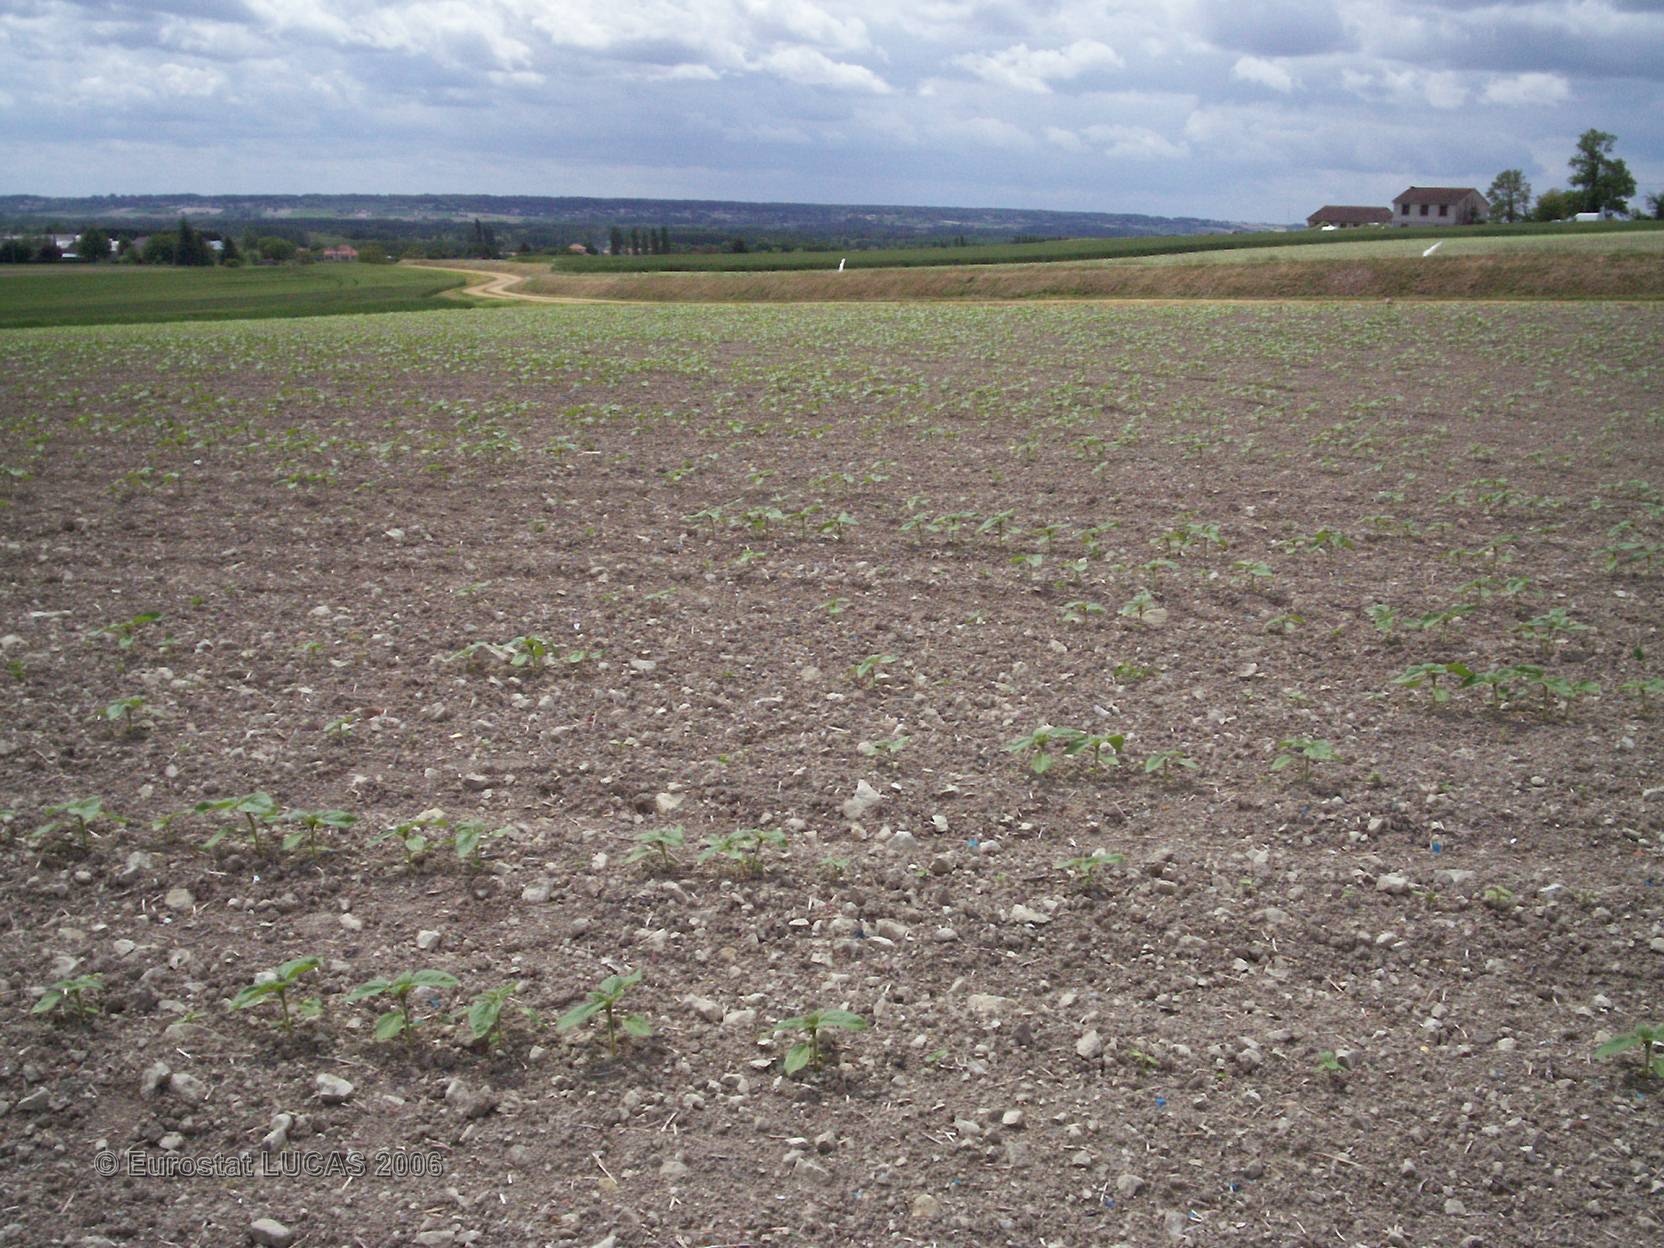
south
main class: Cropland
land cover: Sunflower
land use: Agriculture (excluding fallow land and kitchen gardens)
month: May
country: FR
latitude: 46.8272
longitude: 0.4241
